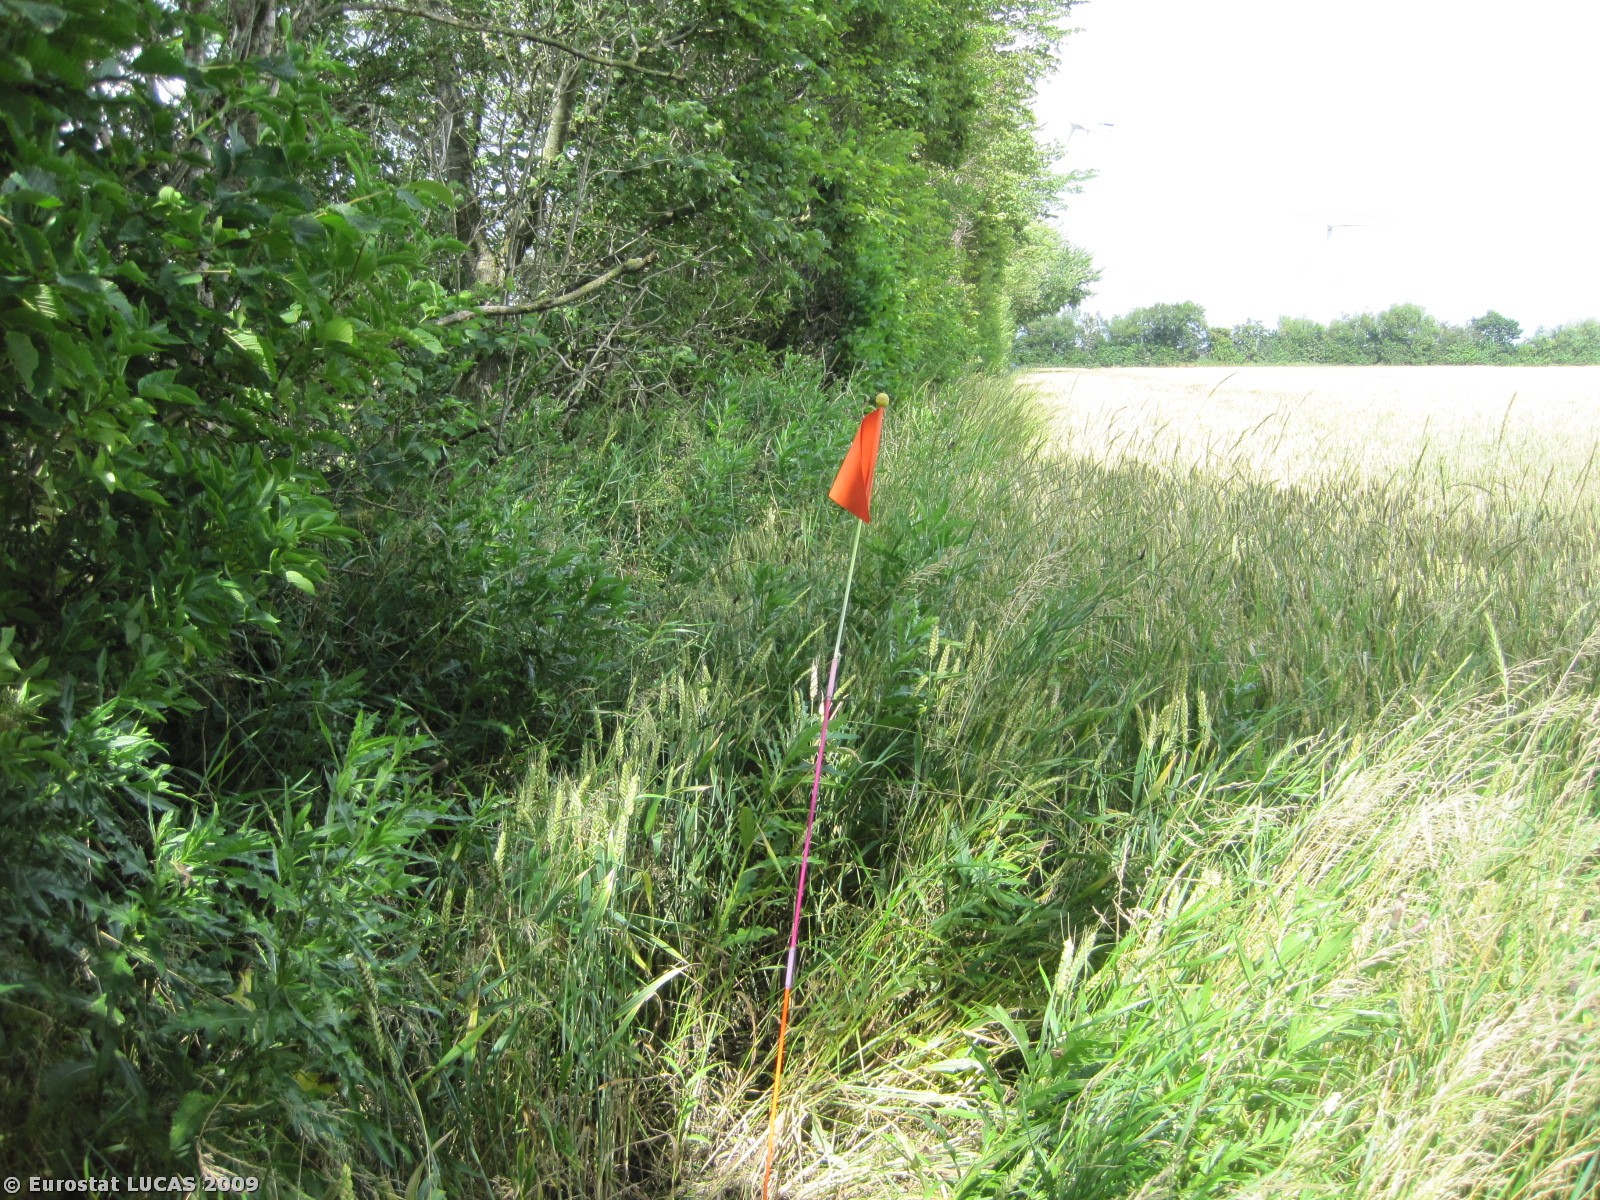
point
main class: Woodland
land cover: Broadleaved woodland
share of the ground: > 75 %
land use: Forestry
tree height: > 5 m
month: July
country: DK
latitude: 57.0269
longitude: 8.7662
